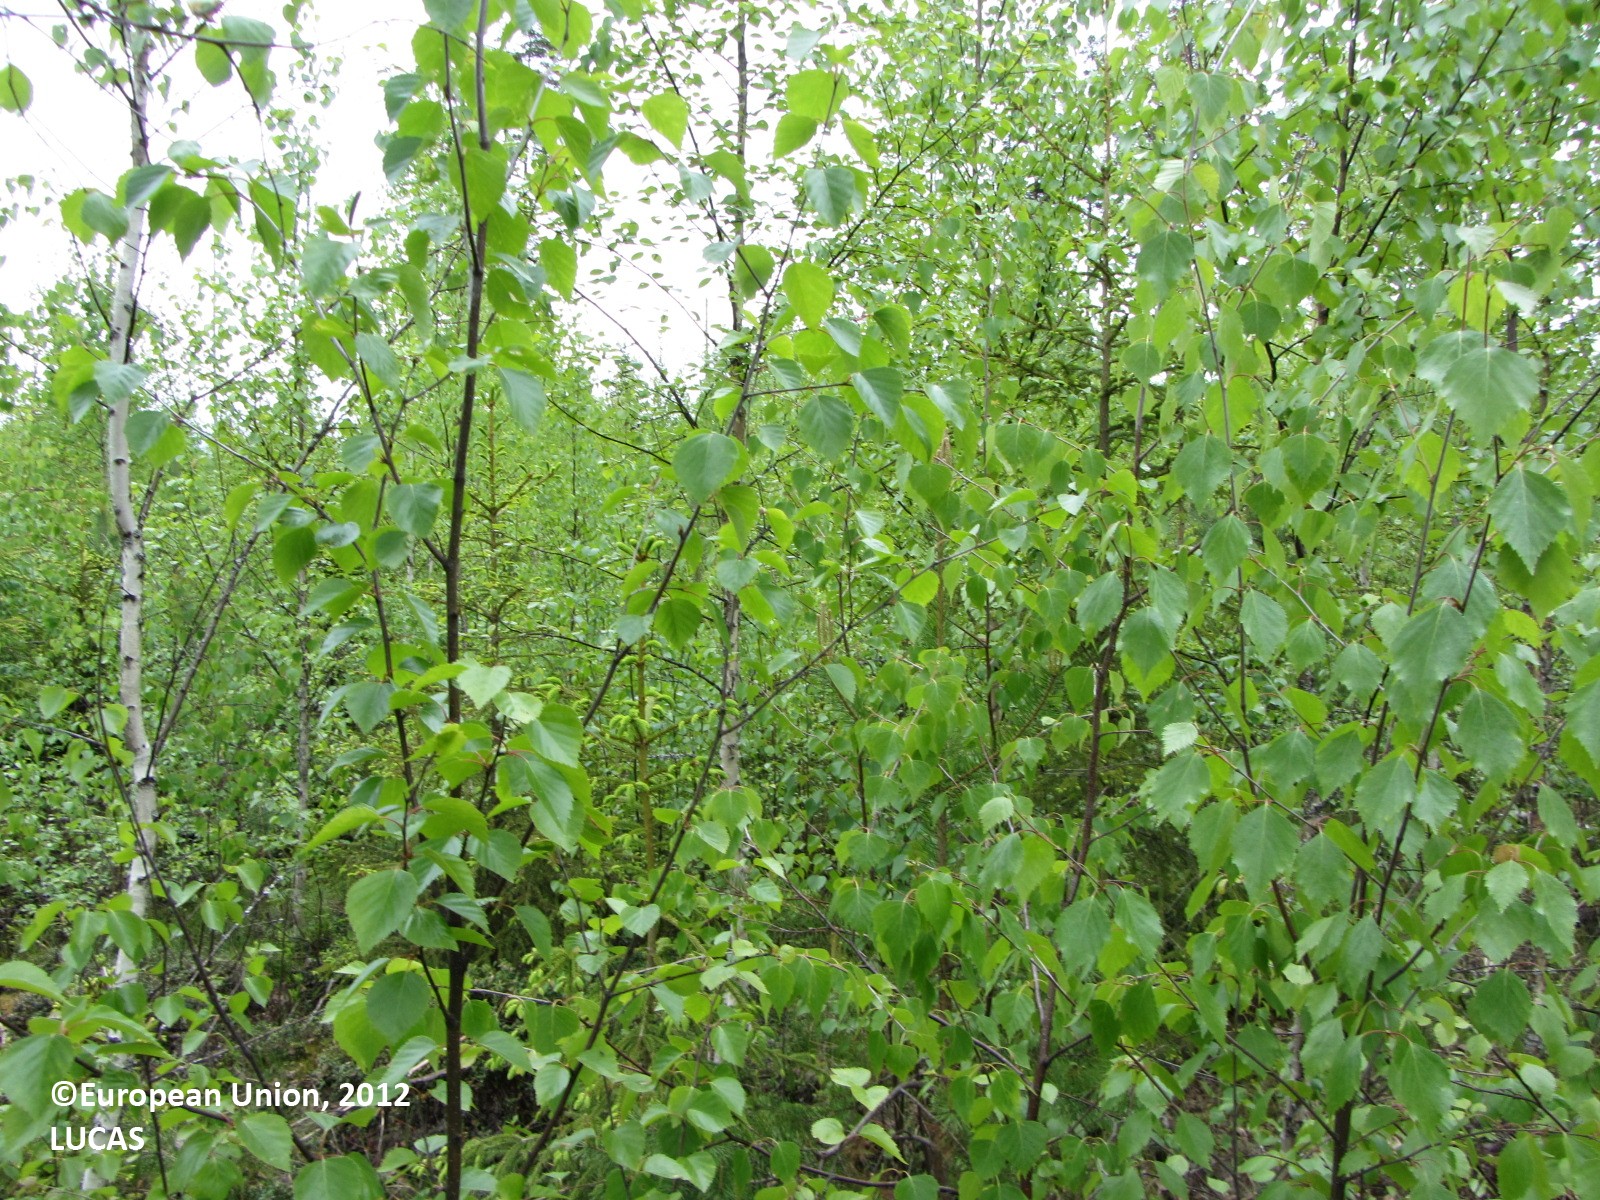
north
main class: Woodland
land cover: Other mixed woodland
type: hemiboreal forest and nemoral coniferous forest and mixed broadleaved-coniferous forest
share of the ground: > 75 %
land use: Forestry
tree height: < 5 m
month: June
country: FI
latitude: 61.7371
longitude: 24.8899
